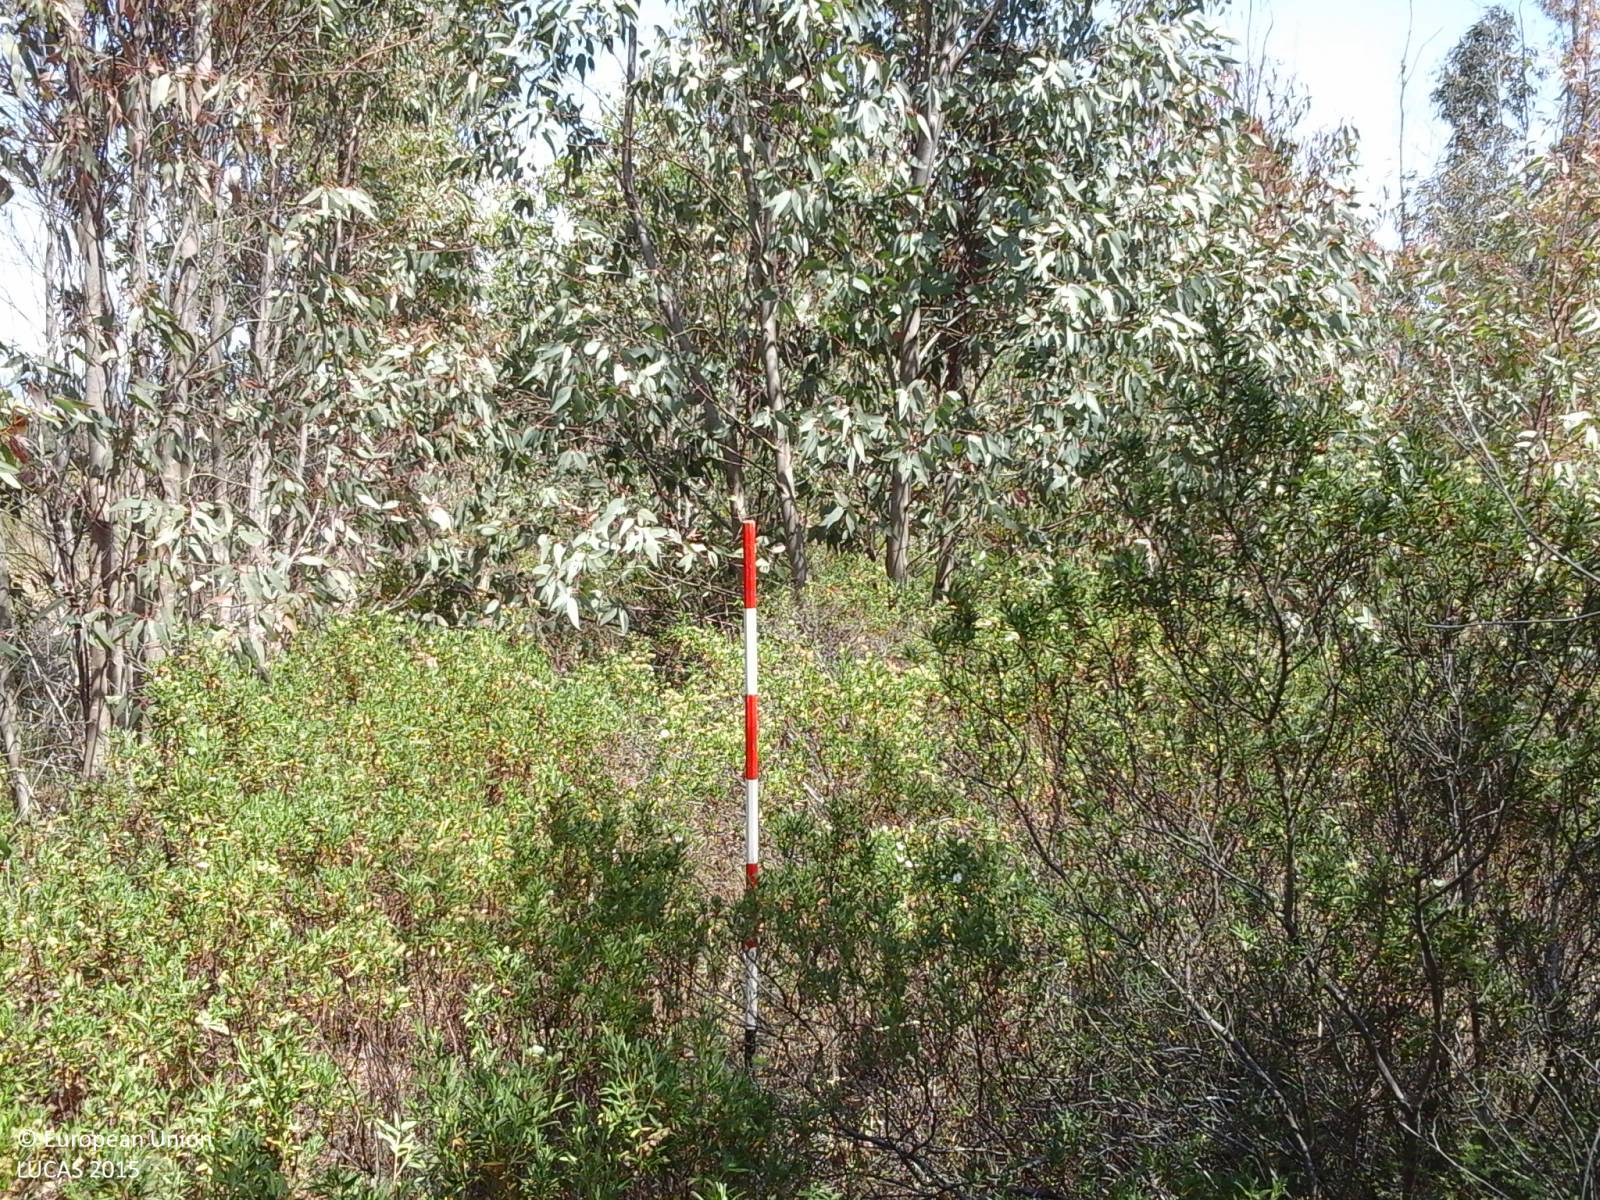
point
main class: Woodland
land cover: Broadleaved woodland
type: exotic forest
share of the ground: > 75 %
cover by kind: broadleaved forest trees 100 %
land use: Forestry
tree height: < 5 m
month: May
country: IT
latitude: 39.7871
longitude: 8.6415
